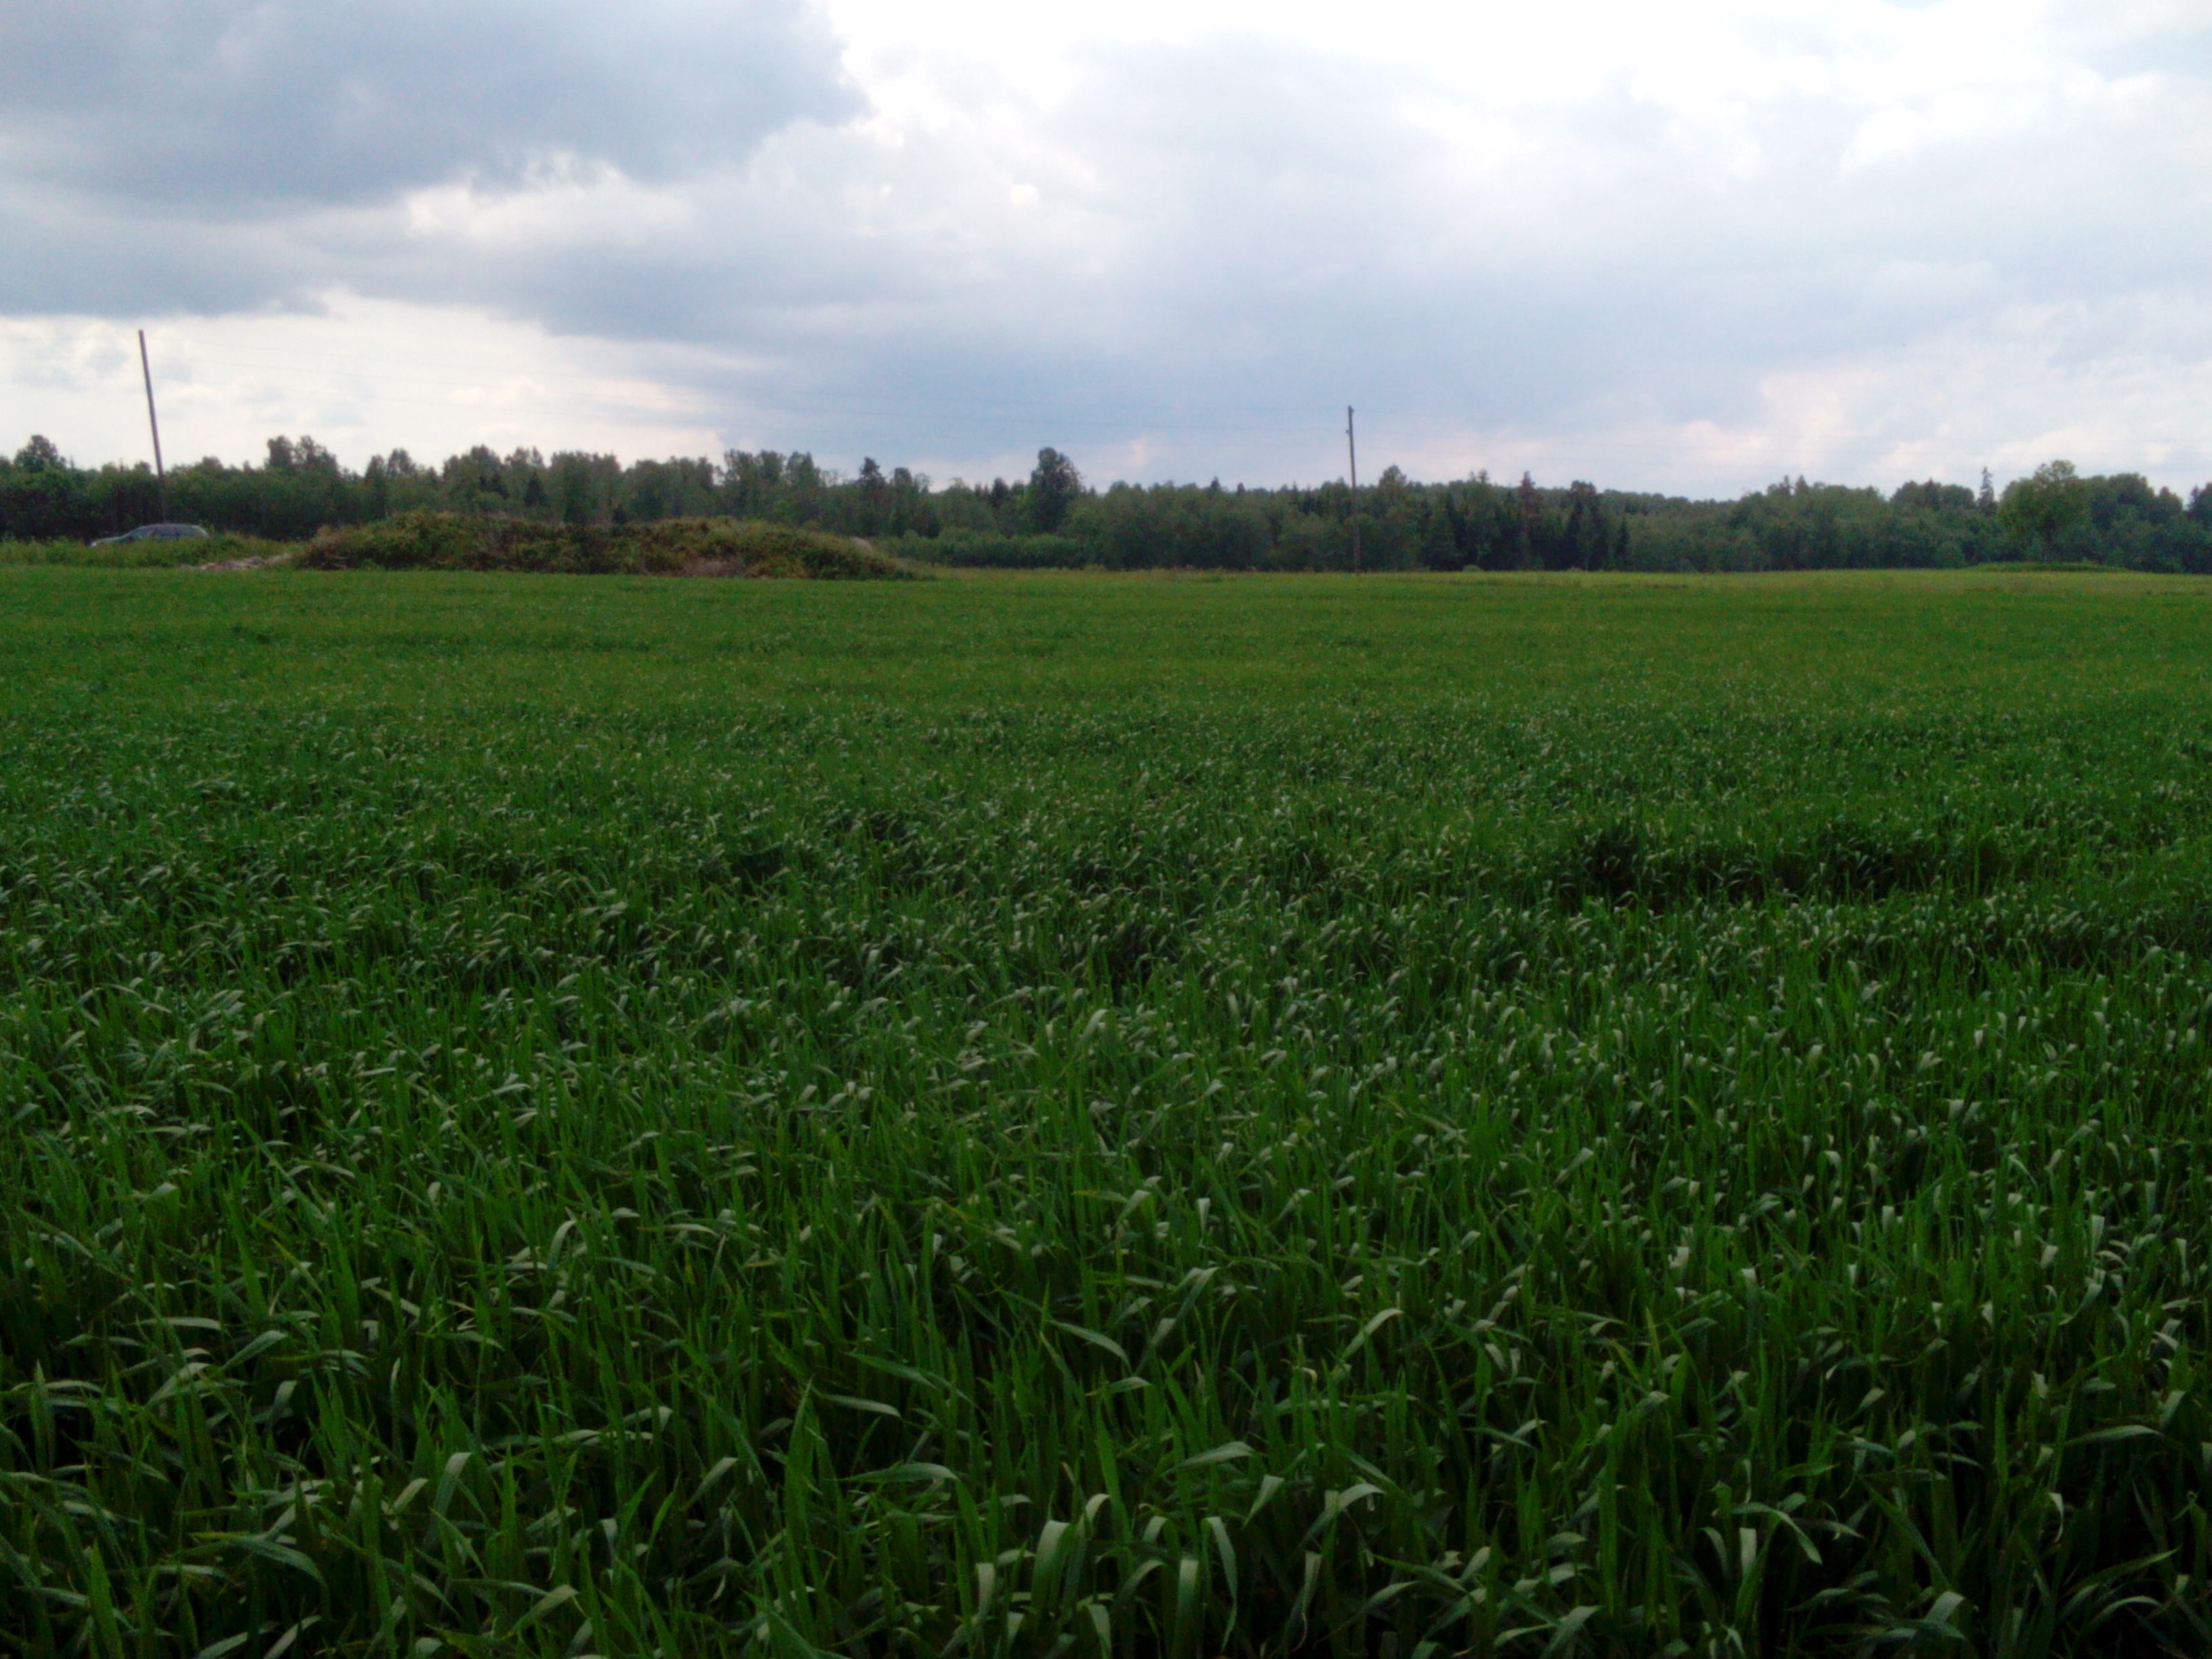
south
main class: Cropland
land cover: Common wheat
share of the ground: > 75 %
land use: Agriculture (excluding fallow land and kitchen gardens)
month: June
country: LV
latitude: 56.7793
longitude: 22.2778
